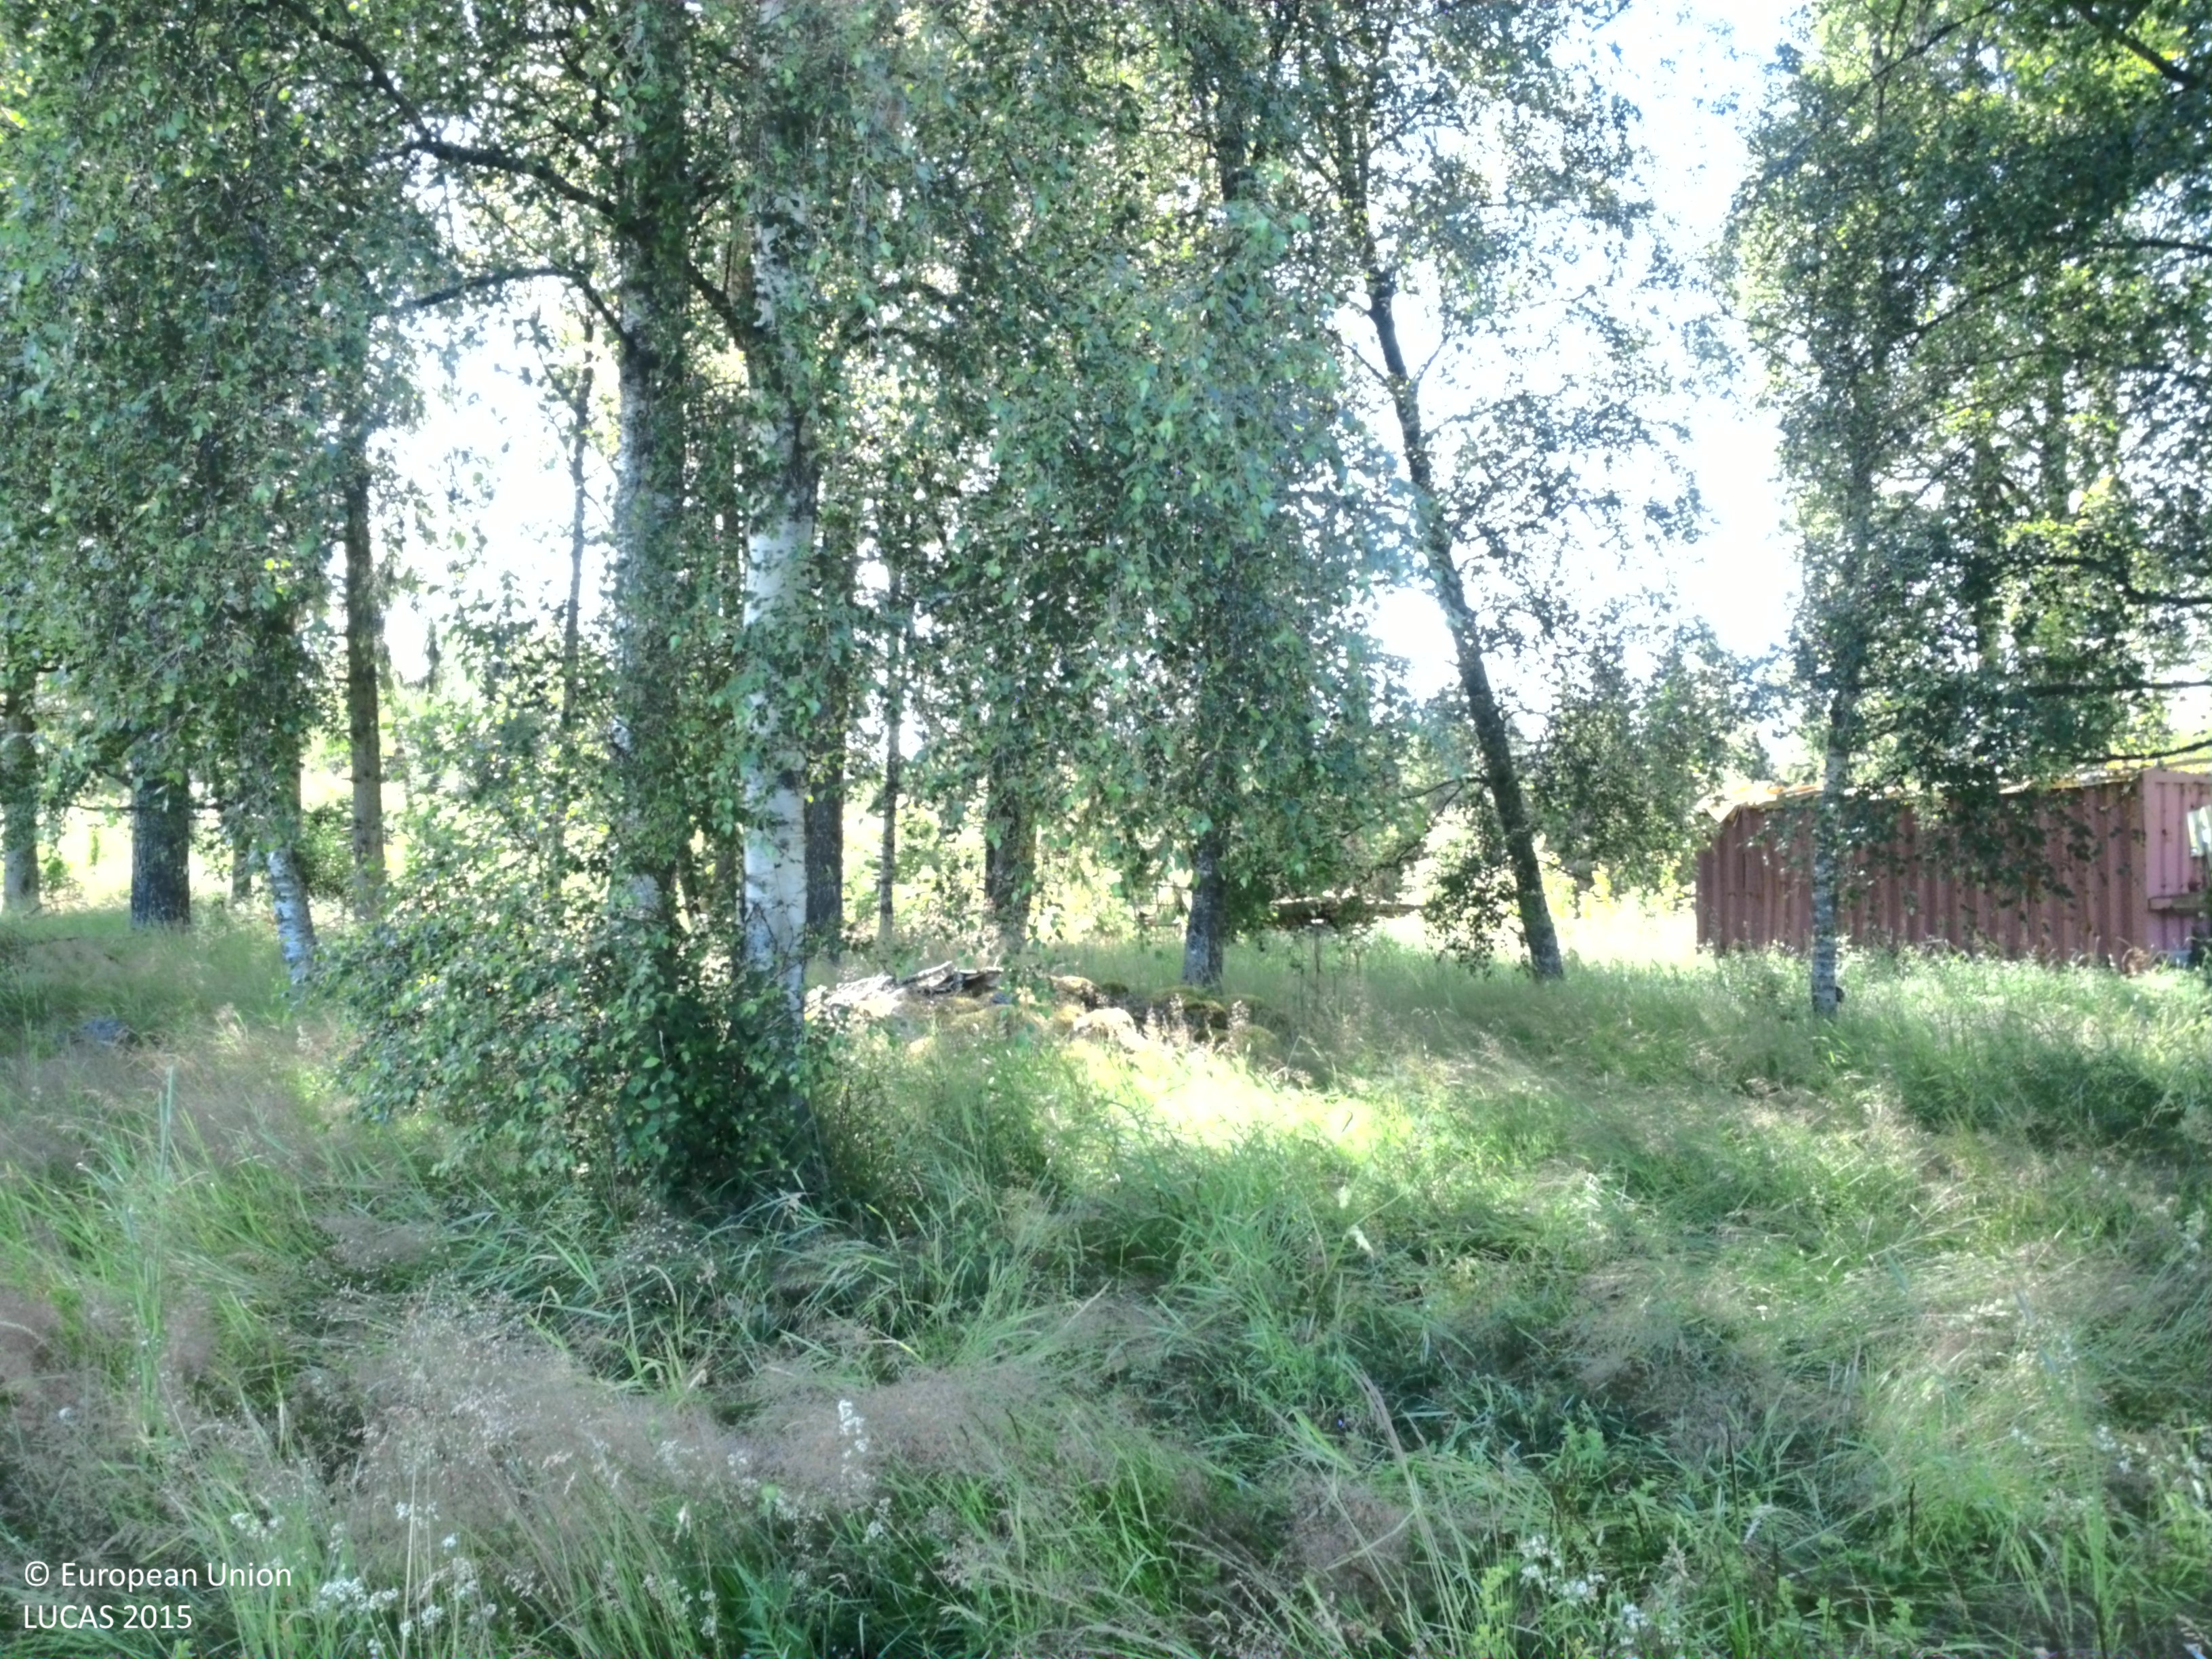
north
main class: Grassland
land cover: Grassland with sparse tree/shrub cover
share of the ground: > 75 %
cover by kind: herbaceous plants 90 %, broadleaved forest trees 5 %, shrubs 5 %
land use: Agriculture (excluding fallow land and kitchen gardens)
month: July
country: SE
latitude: 57.6274
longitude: 14.3324
